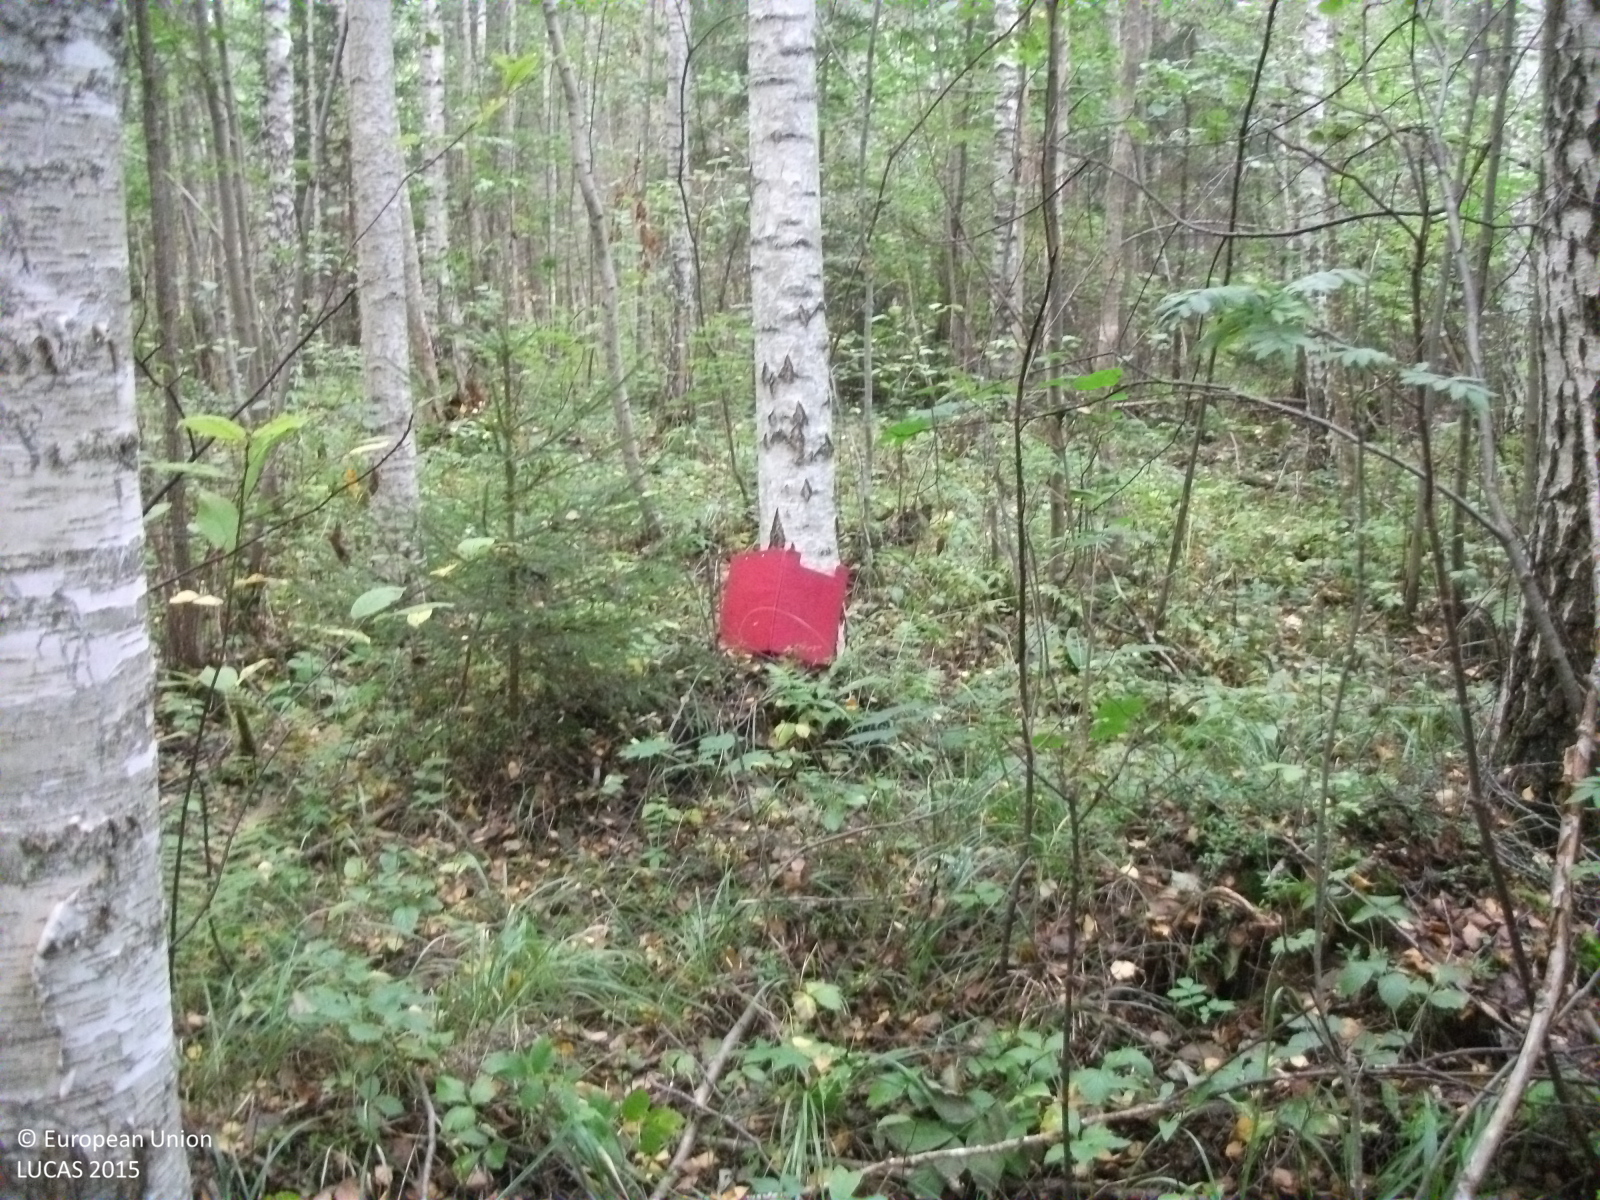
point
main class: Woodland
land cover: Broadleaved woodland
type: non-riverine alder, birch or aspen forest
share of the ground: > 75 %
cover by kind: broadleaved forest trees 85 %, herbaceous plants 10 %, shrubs 5 %
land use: Forestry
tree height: > 5 m
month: September
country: LV
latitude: 57.7088
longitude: 24.4381
